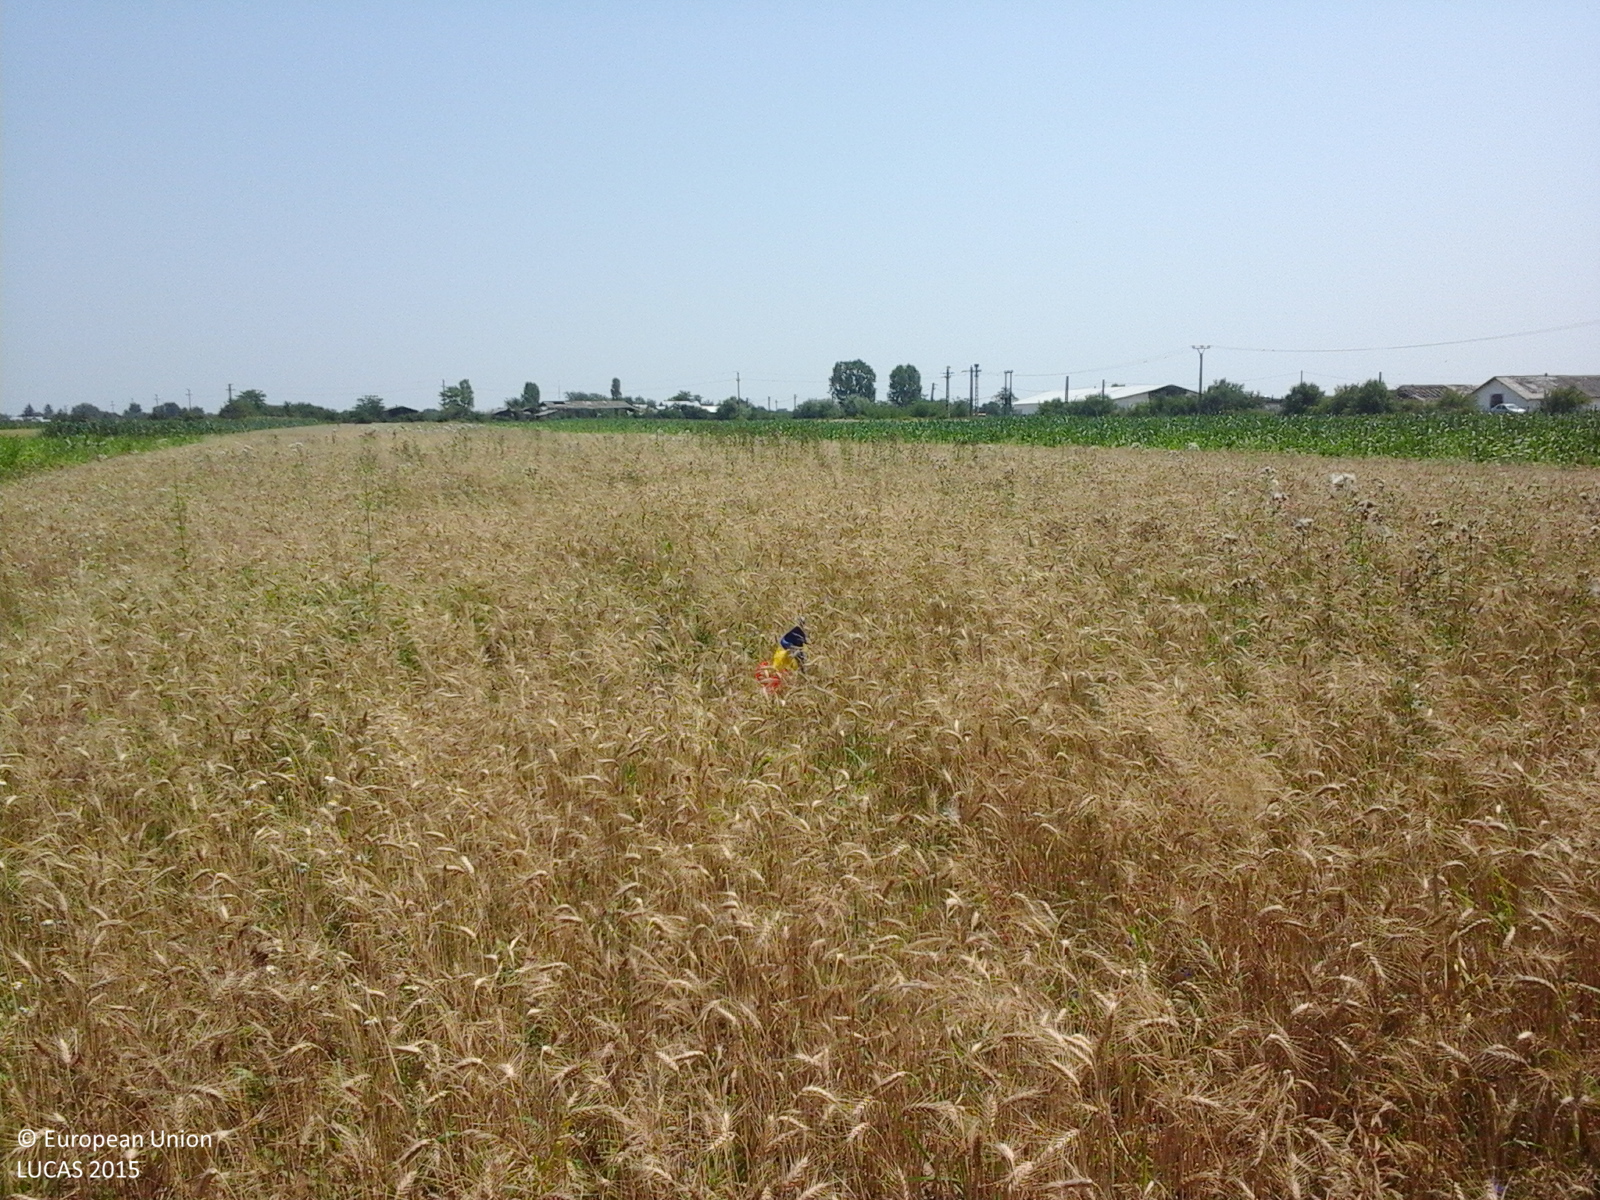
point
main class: Cropland
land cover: Common wheat
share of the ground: > 75 %
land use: Agriculture (excluding fallow land and kitchen gardens)
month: July
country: RO
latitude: 44.7783
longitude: 25.7061
